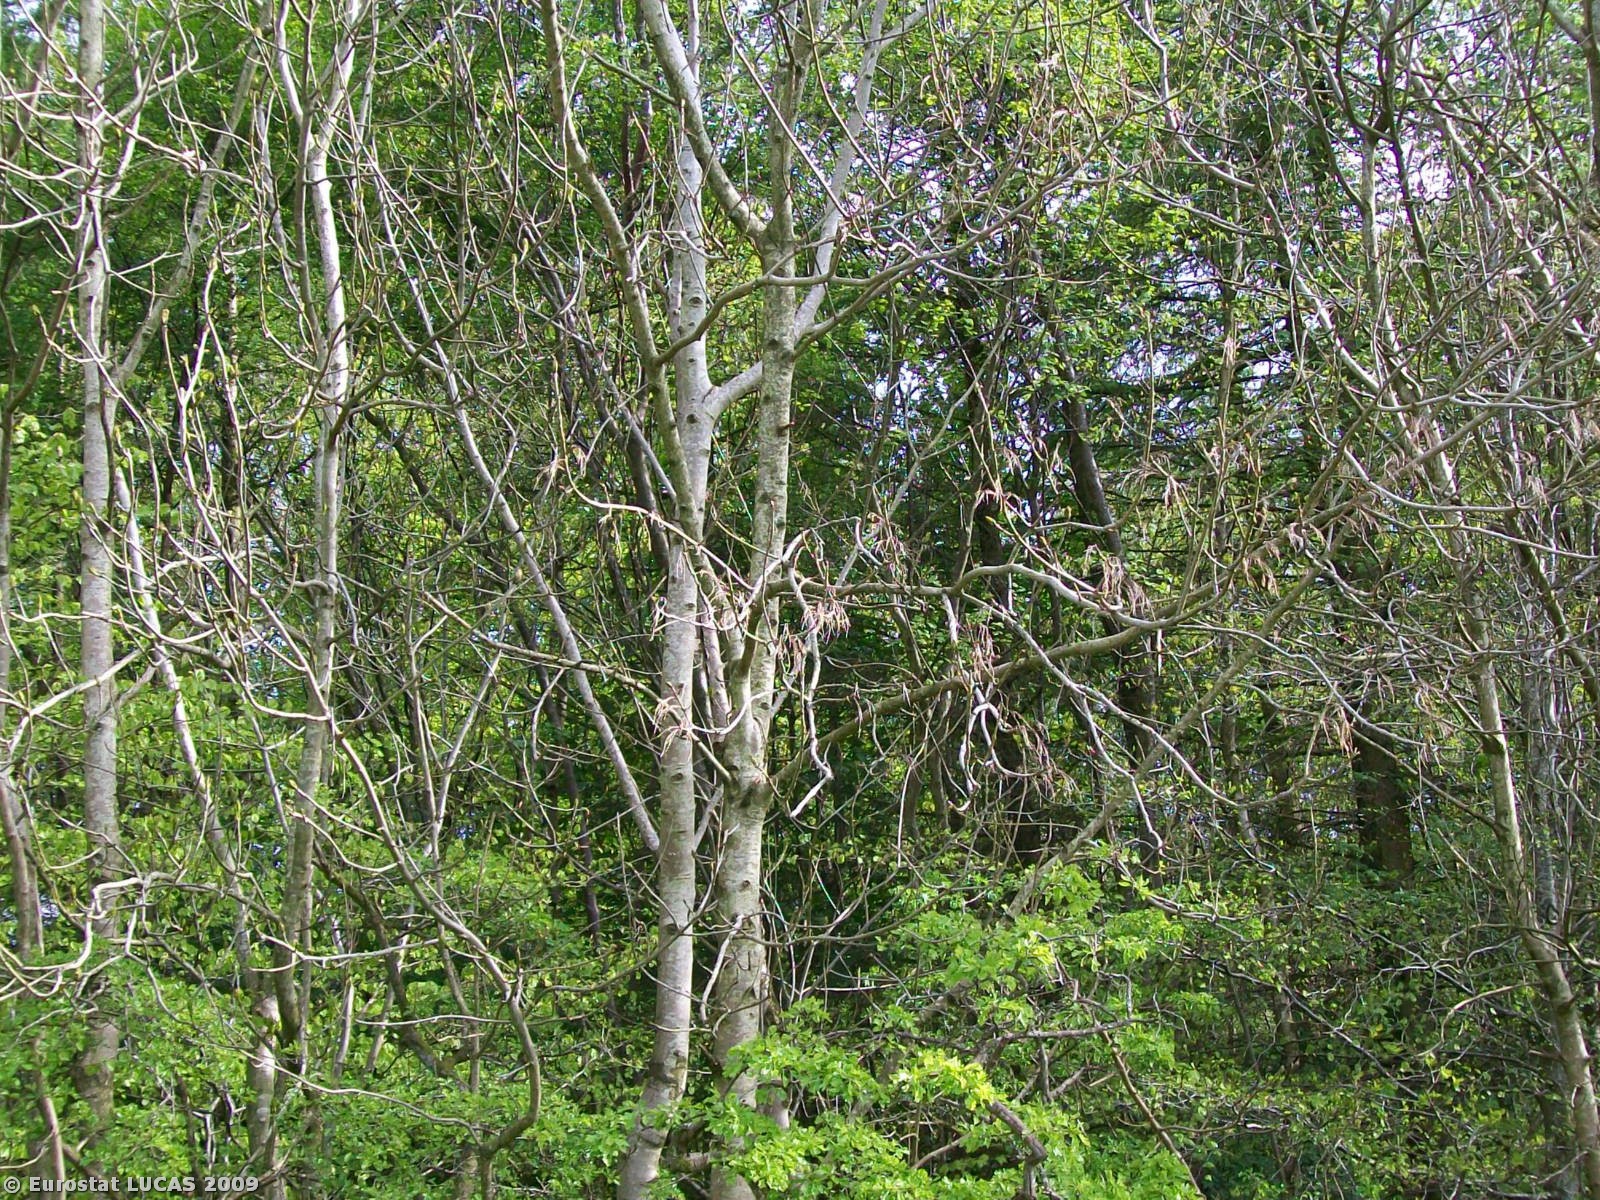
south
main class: Grassland
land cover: Grassland with sparse tree/shrub cover
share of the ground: > 75 %
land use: Agriculture (excluding fallow land and kitchen gardens)
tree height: > 5 m
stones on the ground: < 10 %
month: May
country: GB
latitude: 54.7181
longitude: -3.1935
